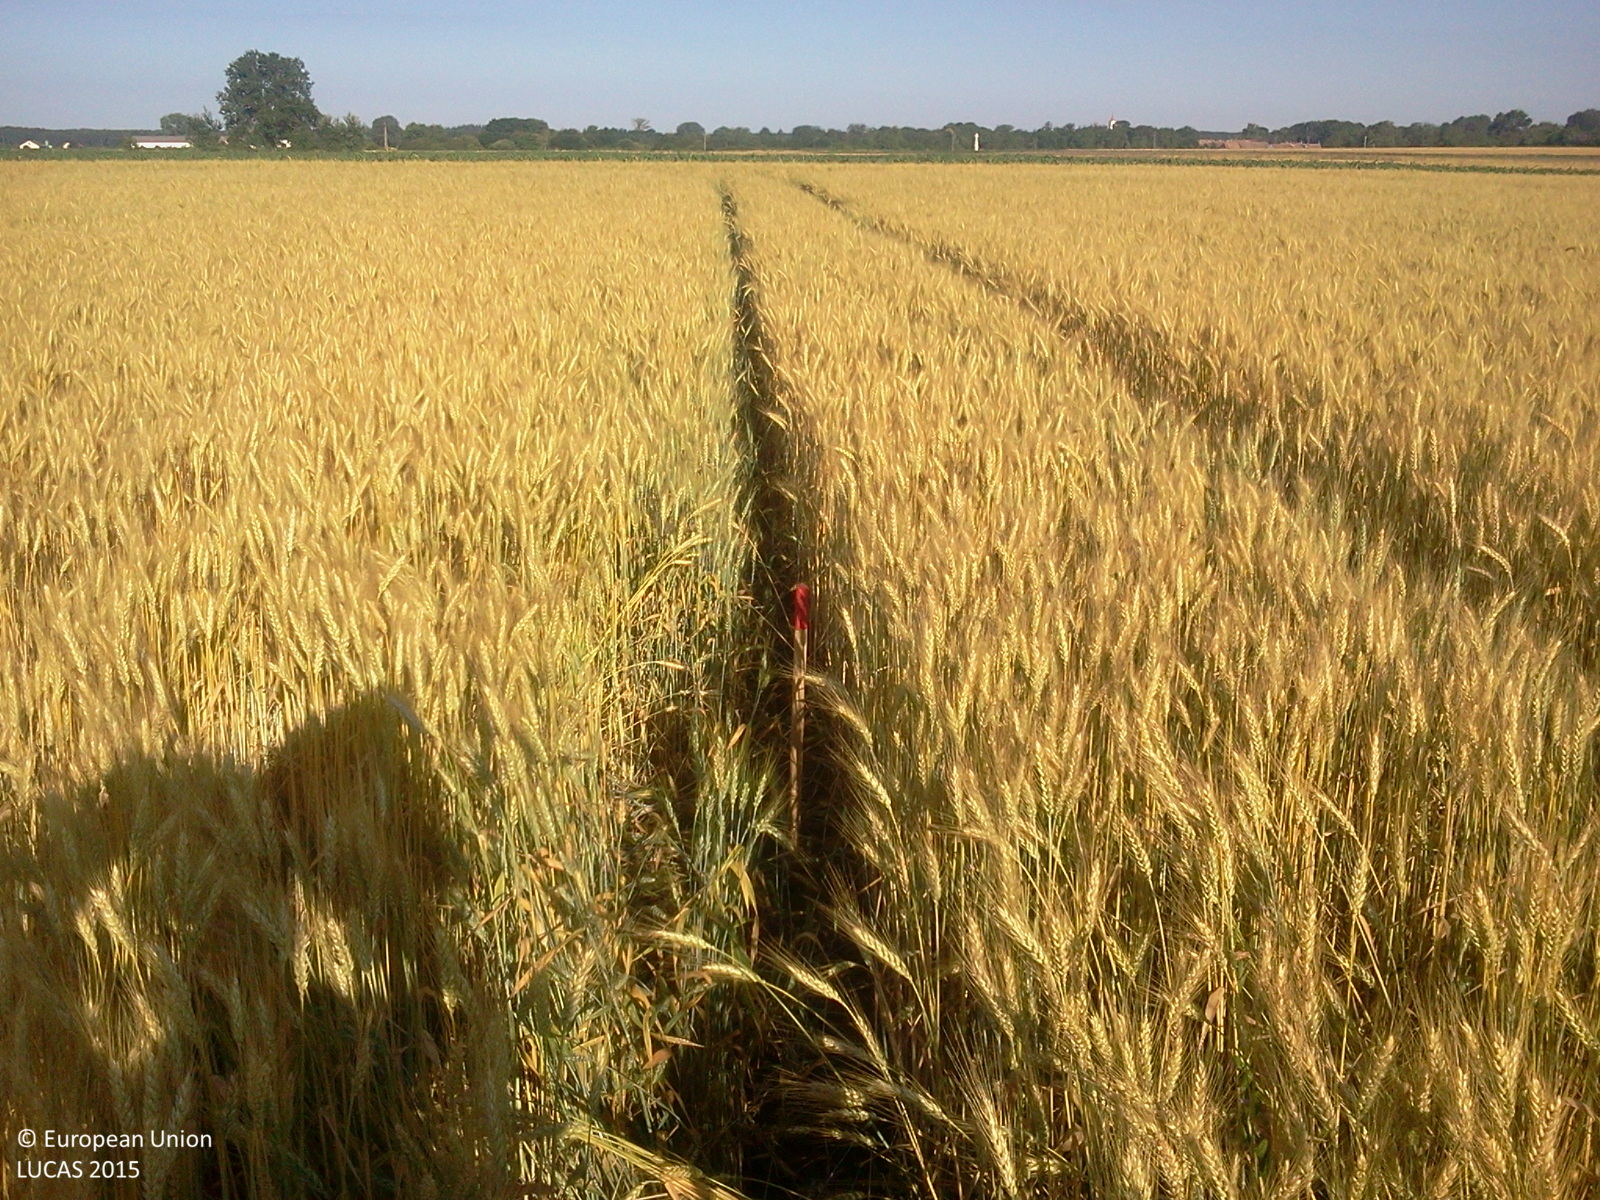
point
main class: Cropland
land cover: Durum wheat
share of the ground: > 75 %
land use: Agriculture (excluding fallow land and kitchen gardens)
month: June
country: HU
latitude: 47.0515
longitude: 17.1531
